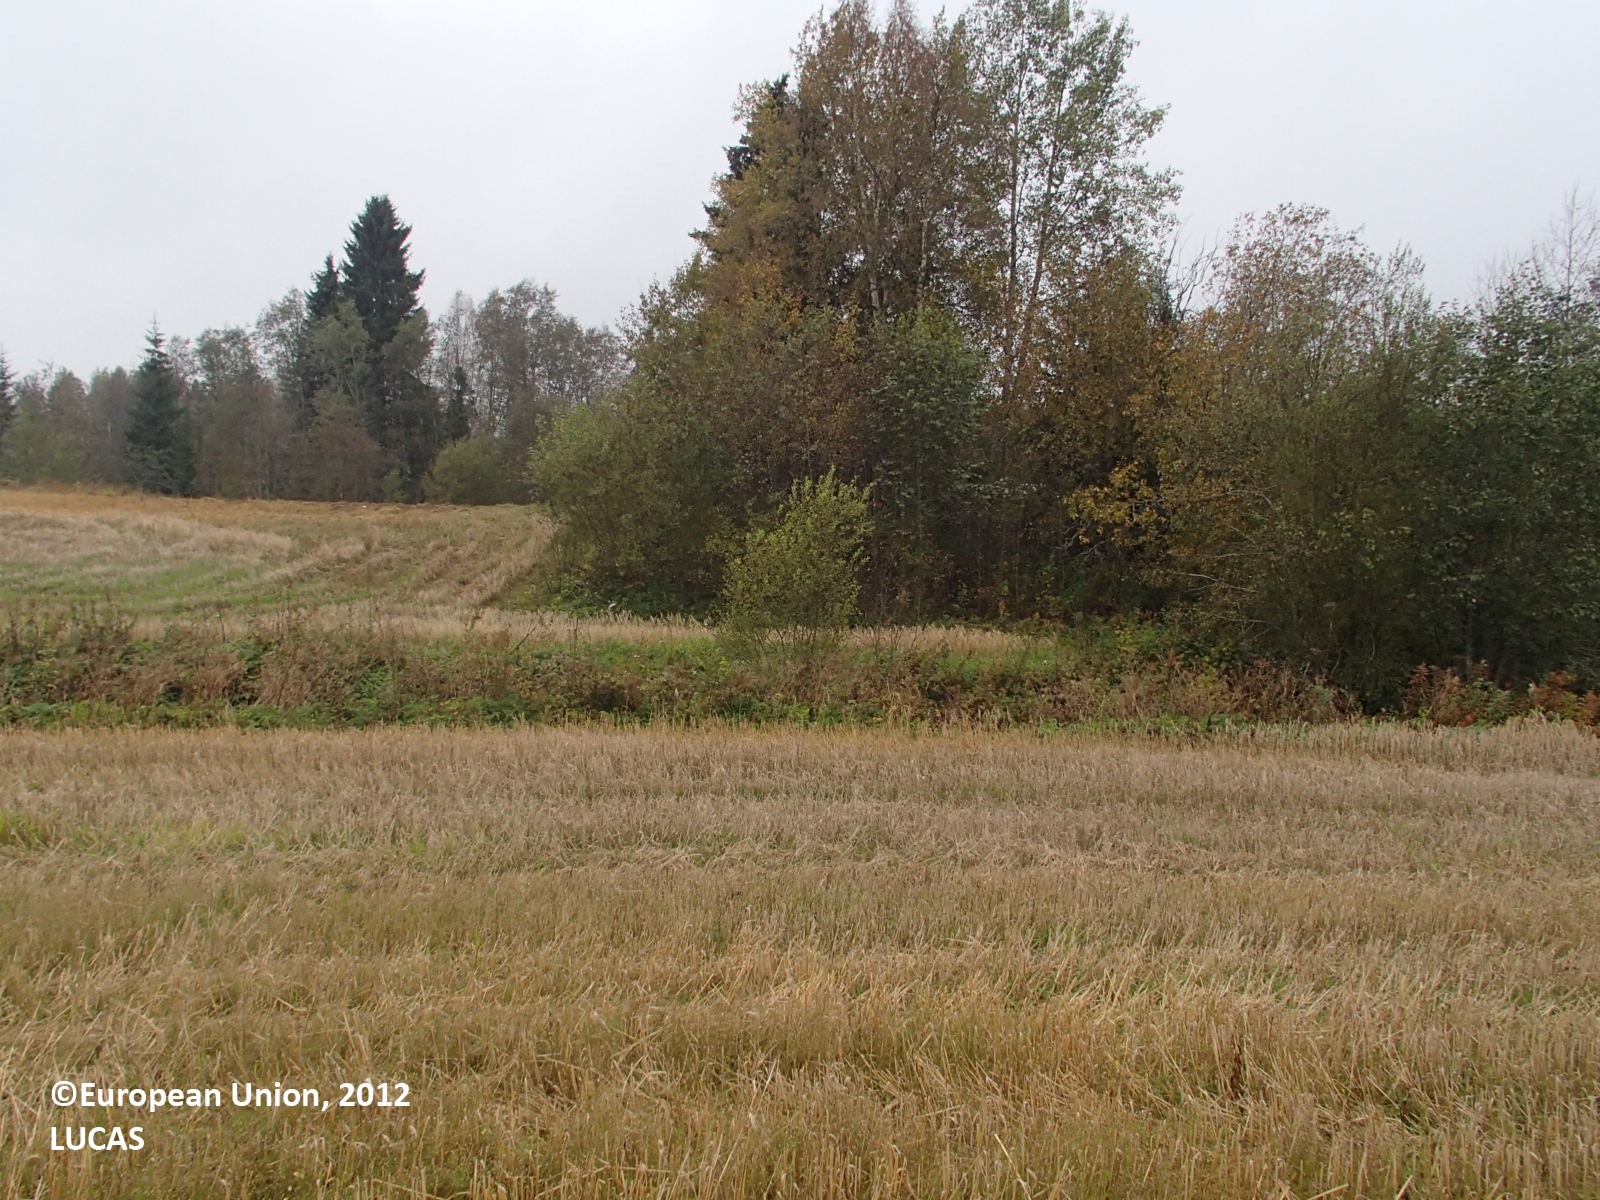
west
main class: Cropland
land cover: Barley
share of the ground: > 75 %
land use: Agriculture (excluding fallow land and kitchen gardens)
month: September
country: FI
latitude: 63.8946
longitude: 26.8549
